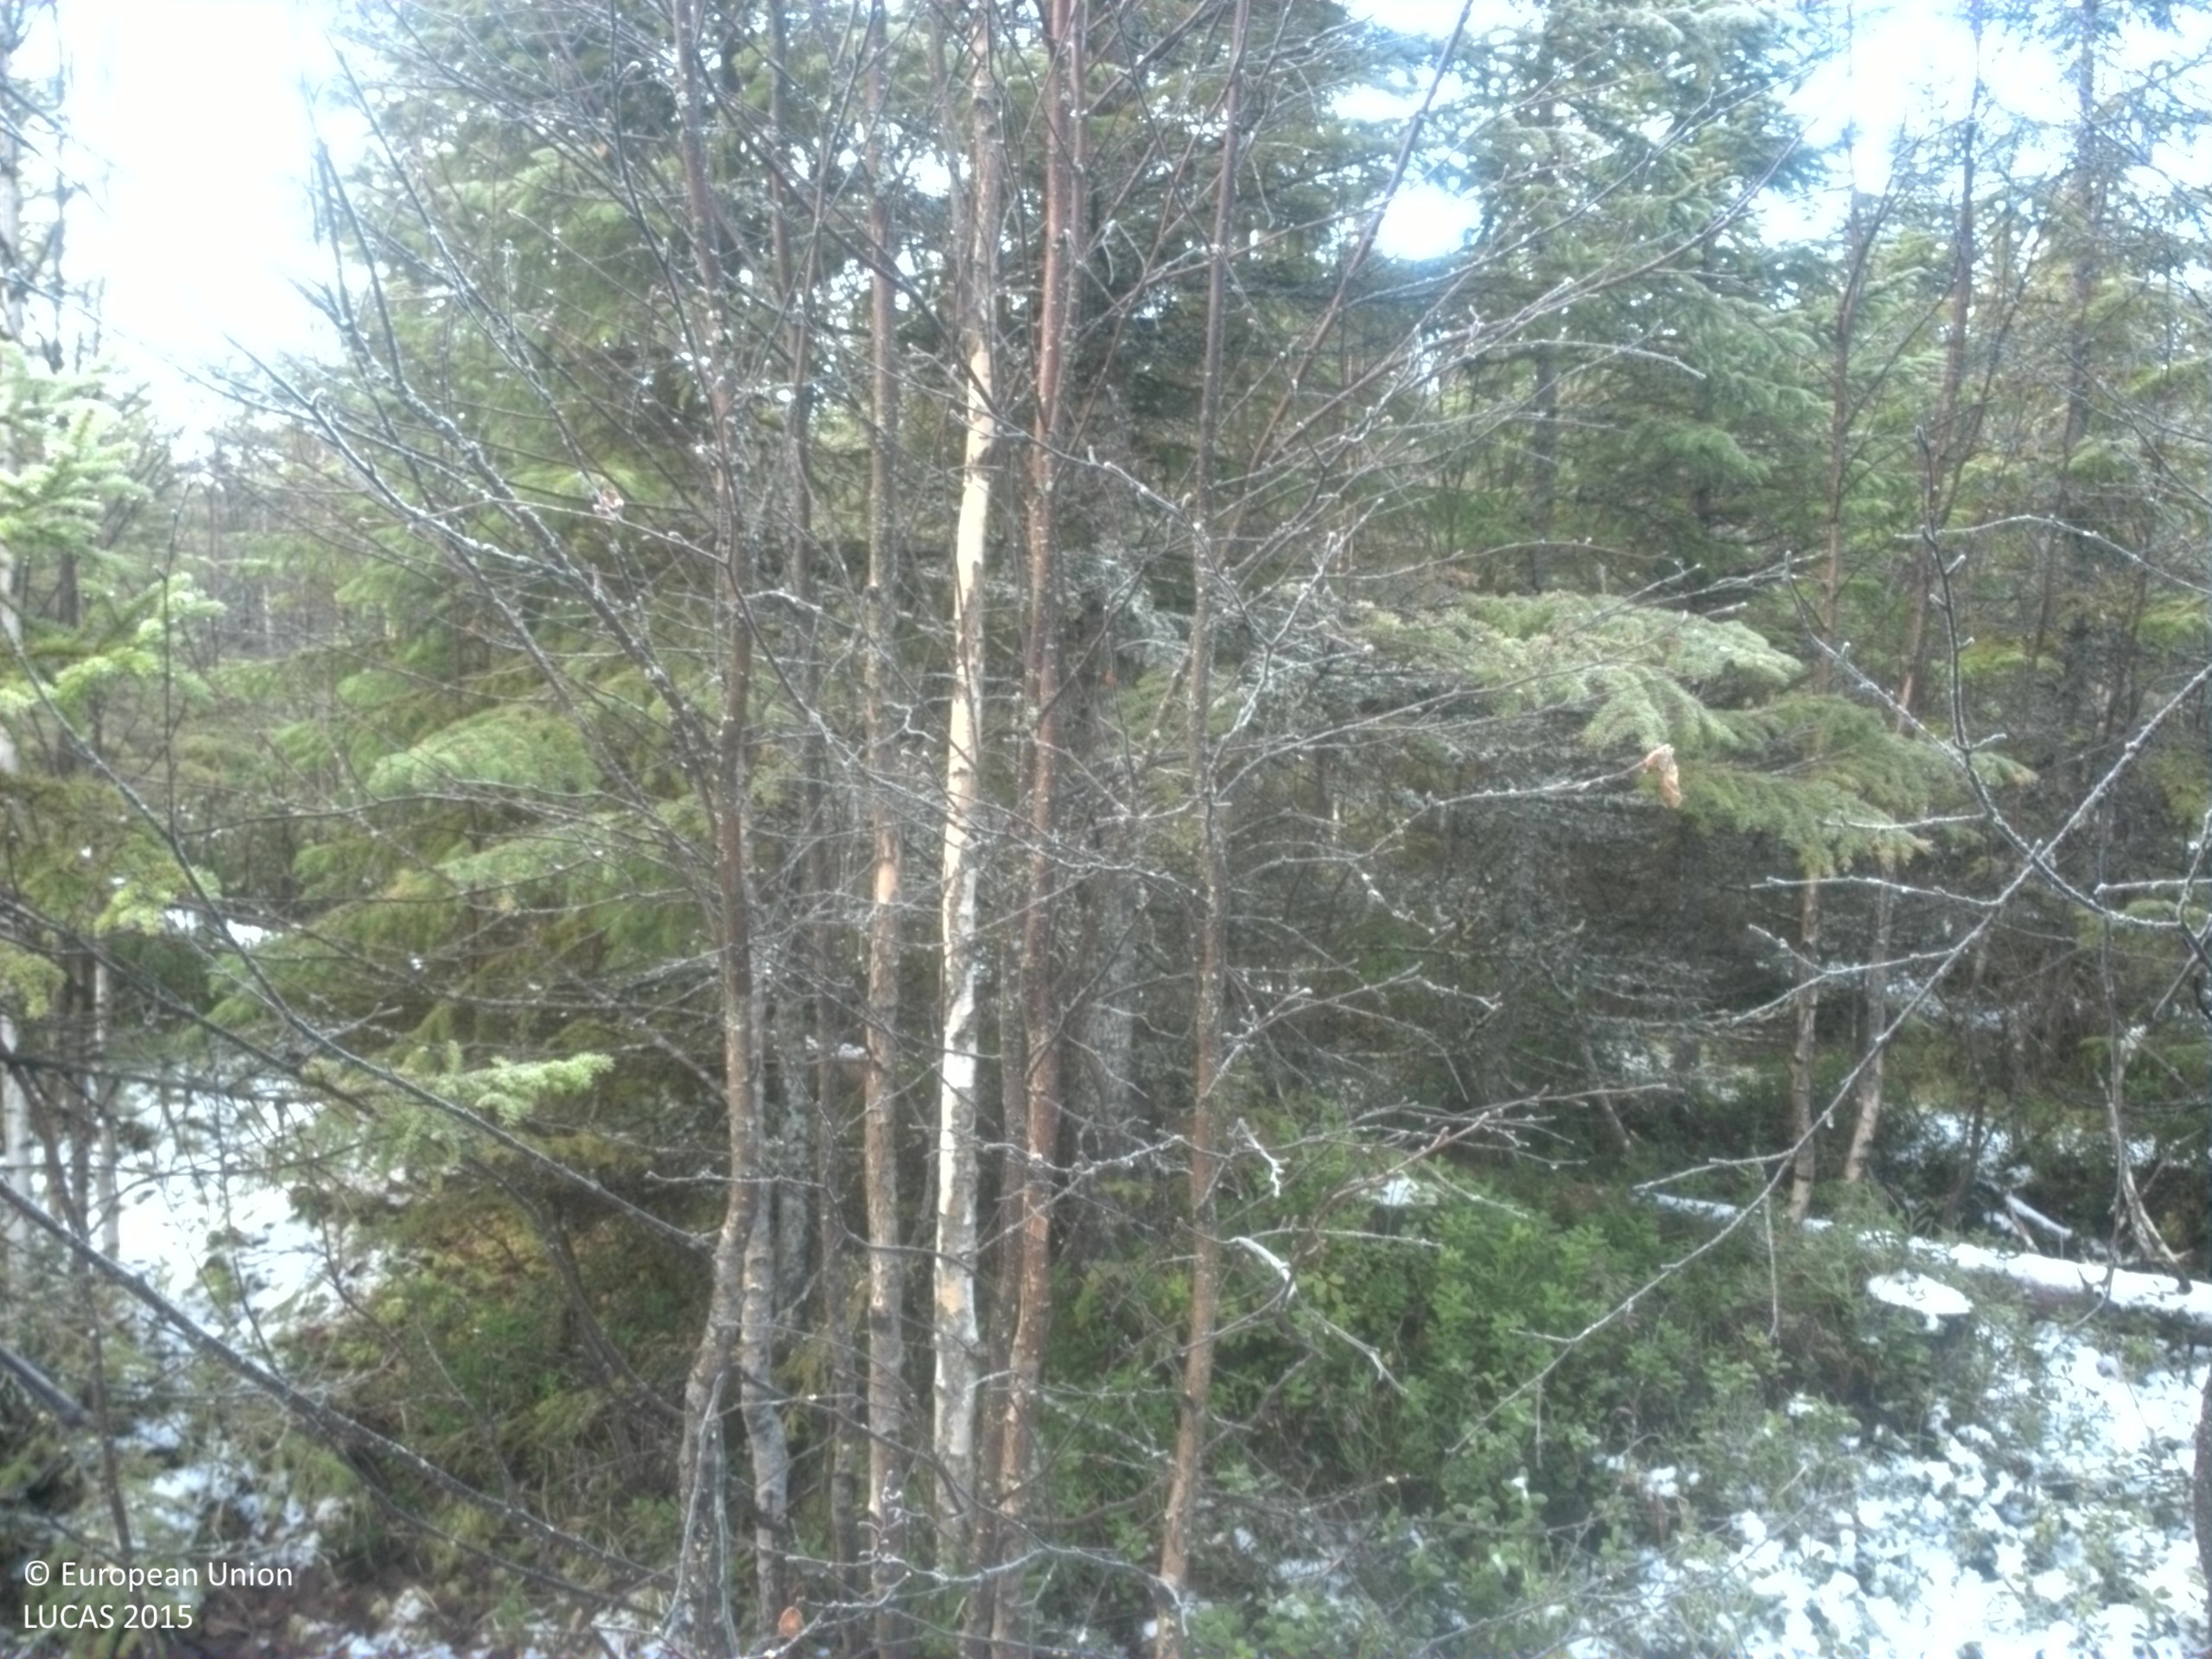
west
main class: Woodland
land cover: Spruce dominated mixed woodland
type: boreal forest
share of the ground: 50 - 75 %
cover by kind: coniferous forest trees 35 %, shrubs 25 %, broadleaved forest trees 15 %, lichens and mosses 15 %, herbaceous plants 10 %
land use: Forestry
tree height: < 5 m
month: November
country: SE
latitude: 63.9050
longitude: 15.9833
